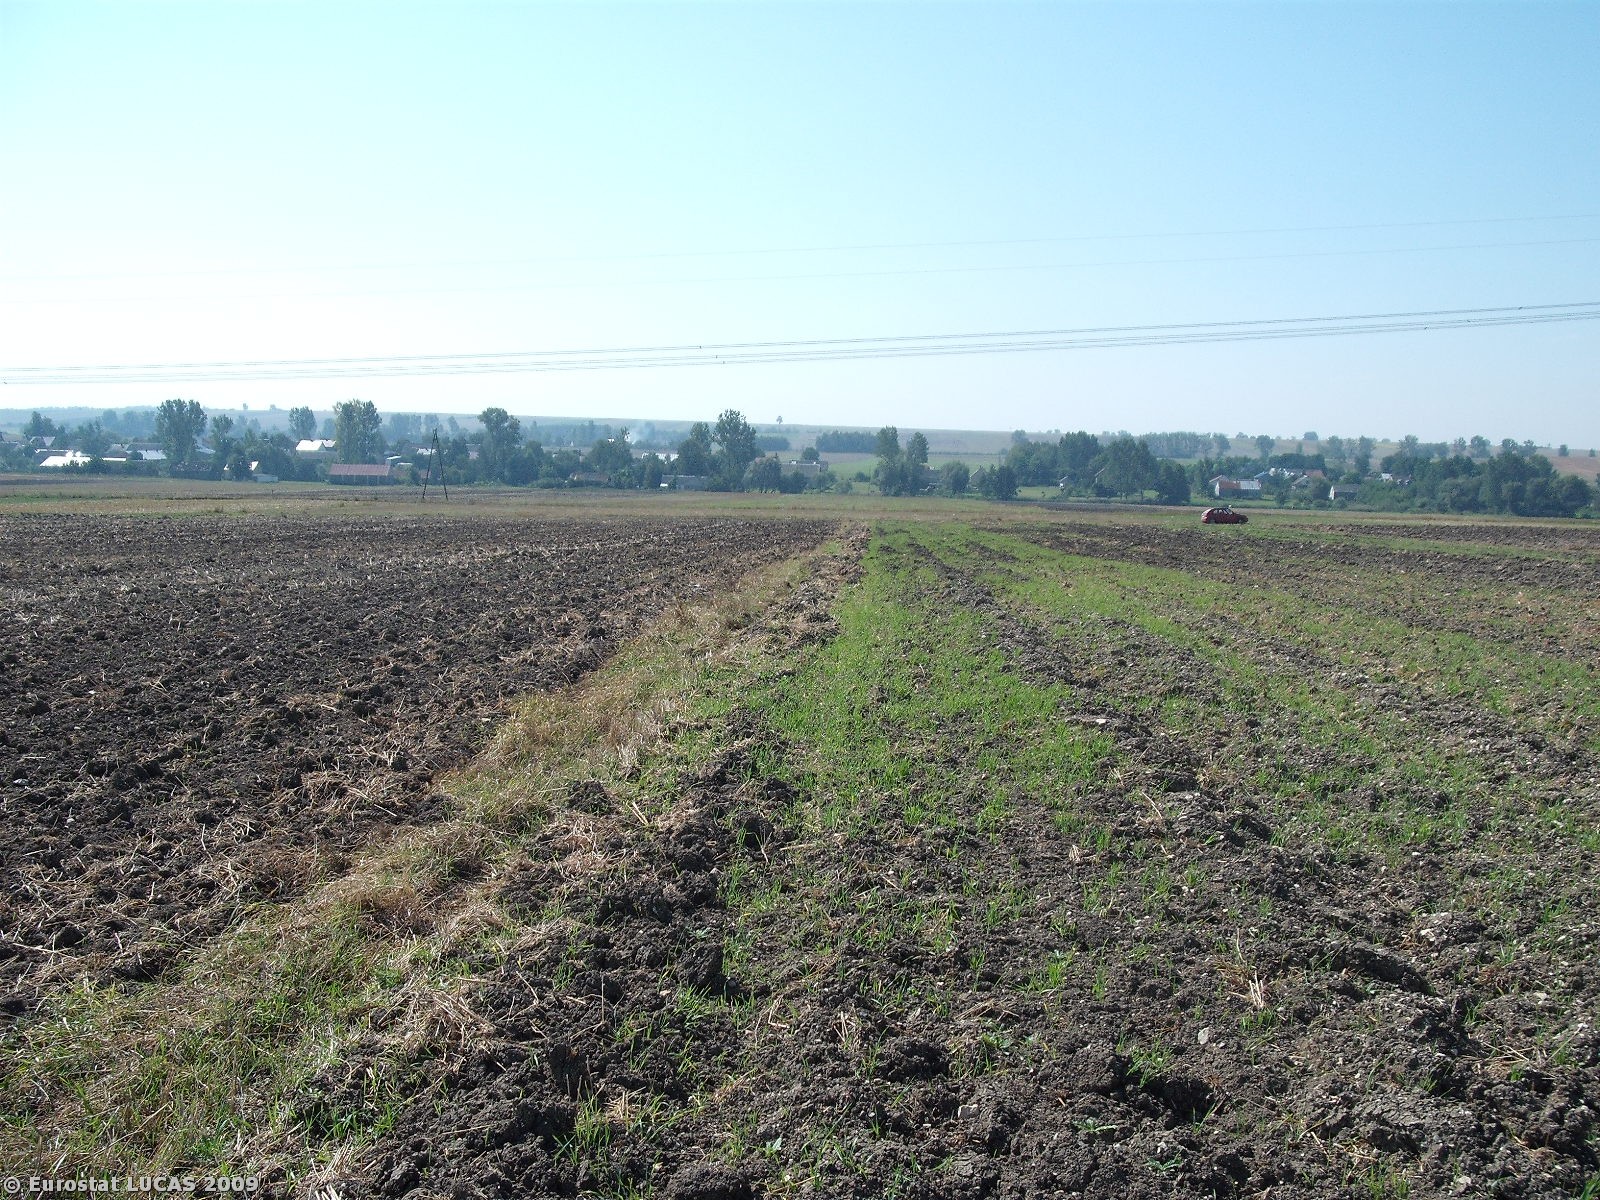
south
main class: Cropland
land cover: Triticale
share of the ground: < 10 %
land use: Agriculture (excluding fallow land and kitchen gardens)
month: September
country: PL
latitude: 50.6118
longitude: 20.4241
